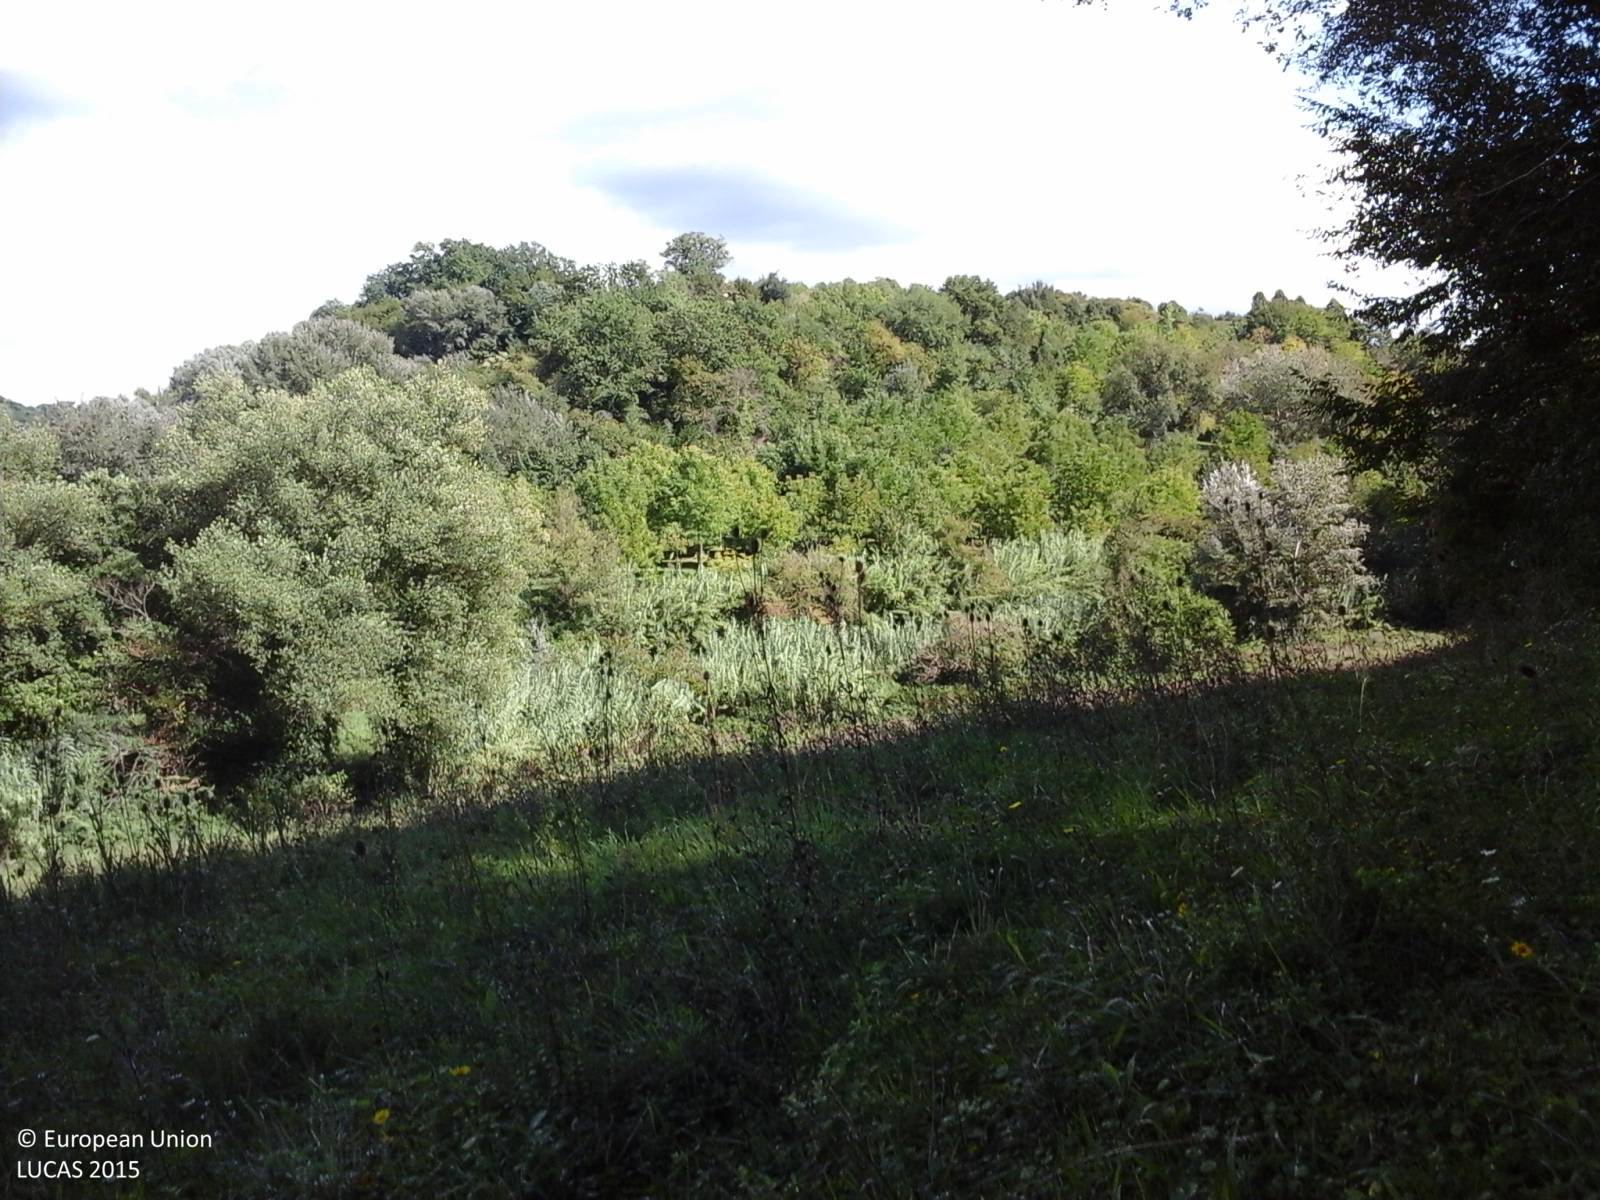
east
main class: Woodland
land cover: Broadleaved woodland
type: thermophilous deciduous forest
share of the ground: > 75 %
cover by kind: broadleaved forest trees 100 %
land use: Semi-natural and natural areas not in use
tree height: > 5 m
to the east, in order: Broadleaved woodland; Grassland without tree/shrub cover; Broadleaved woodland; Ditches and canals; Broadleaved woodland; Tracks; Broadleaved woodland; Fences; Nuts trees
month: September
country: IT
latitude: 42.3502
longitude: 12.5770
